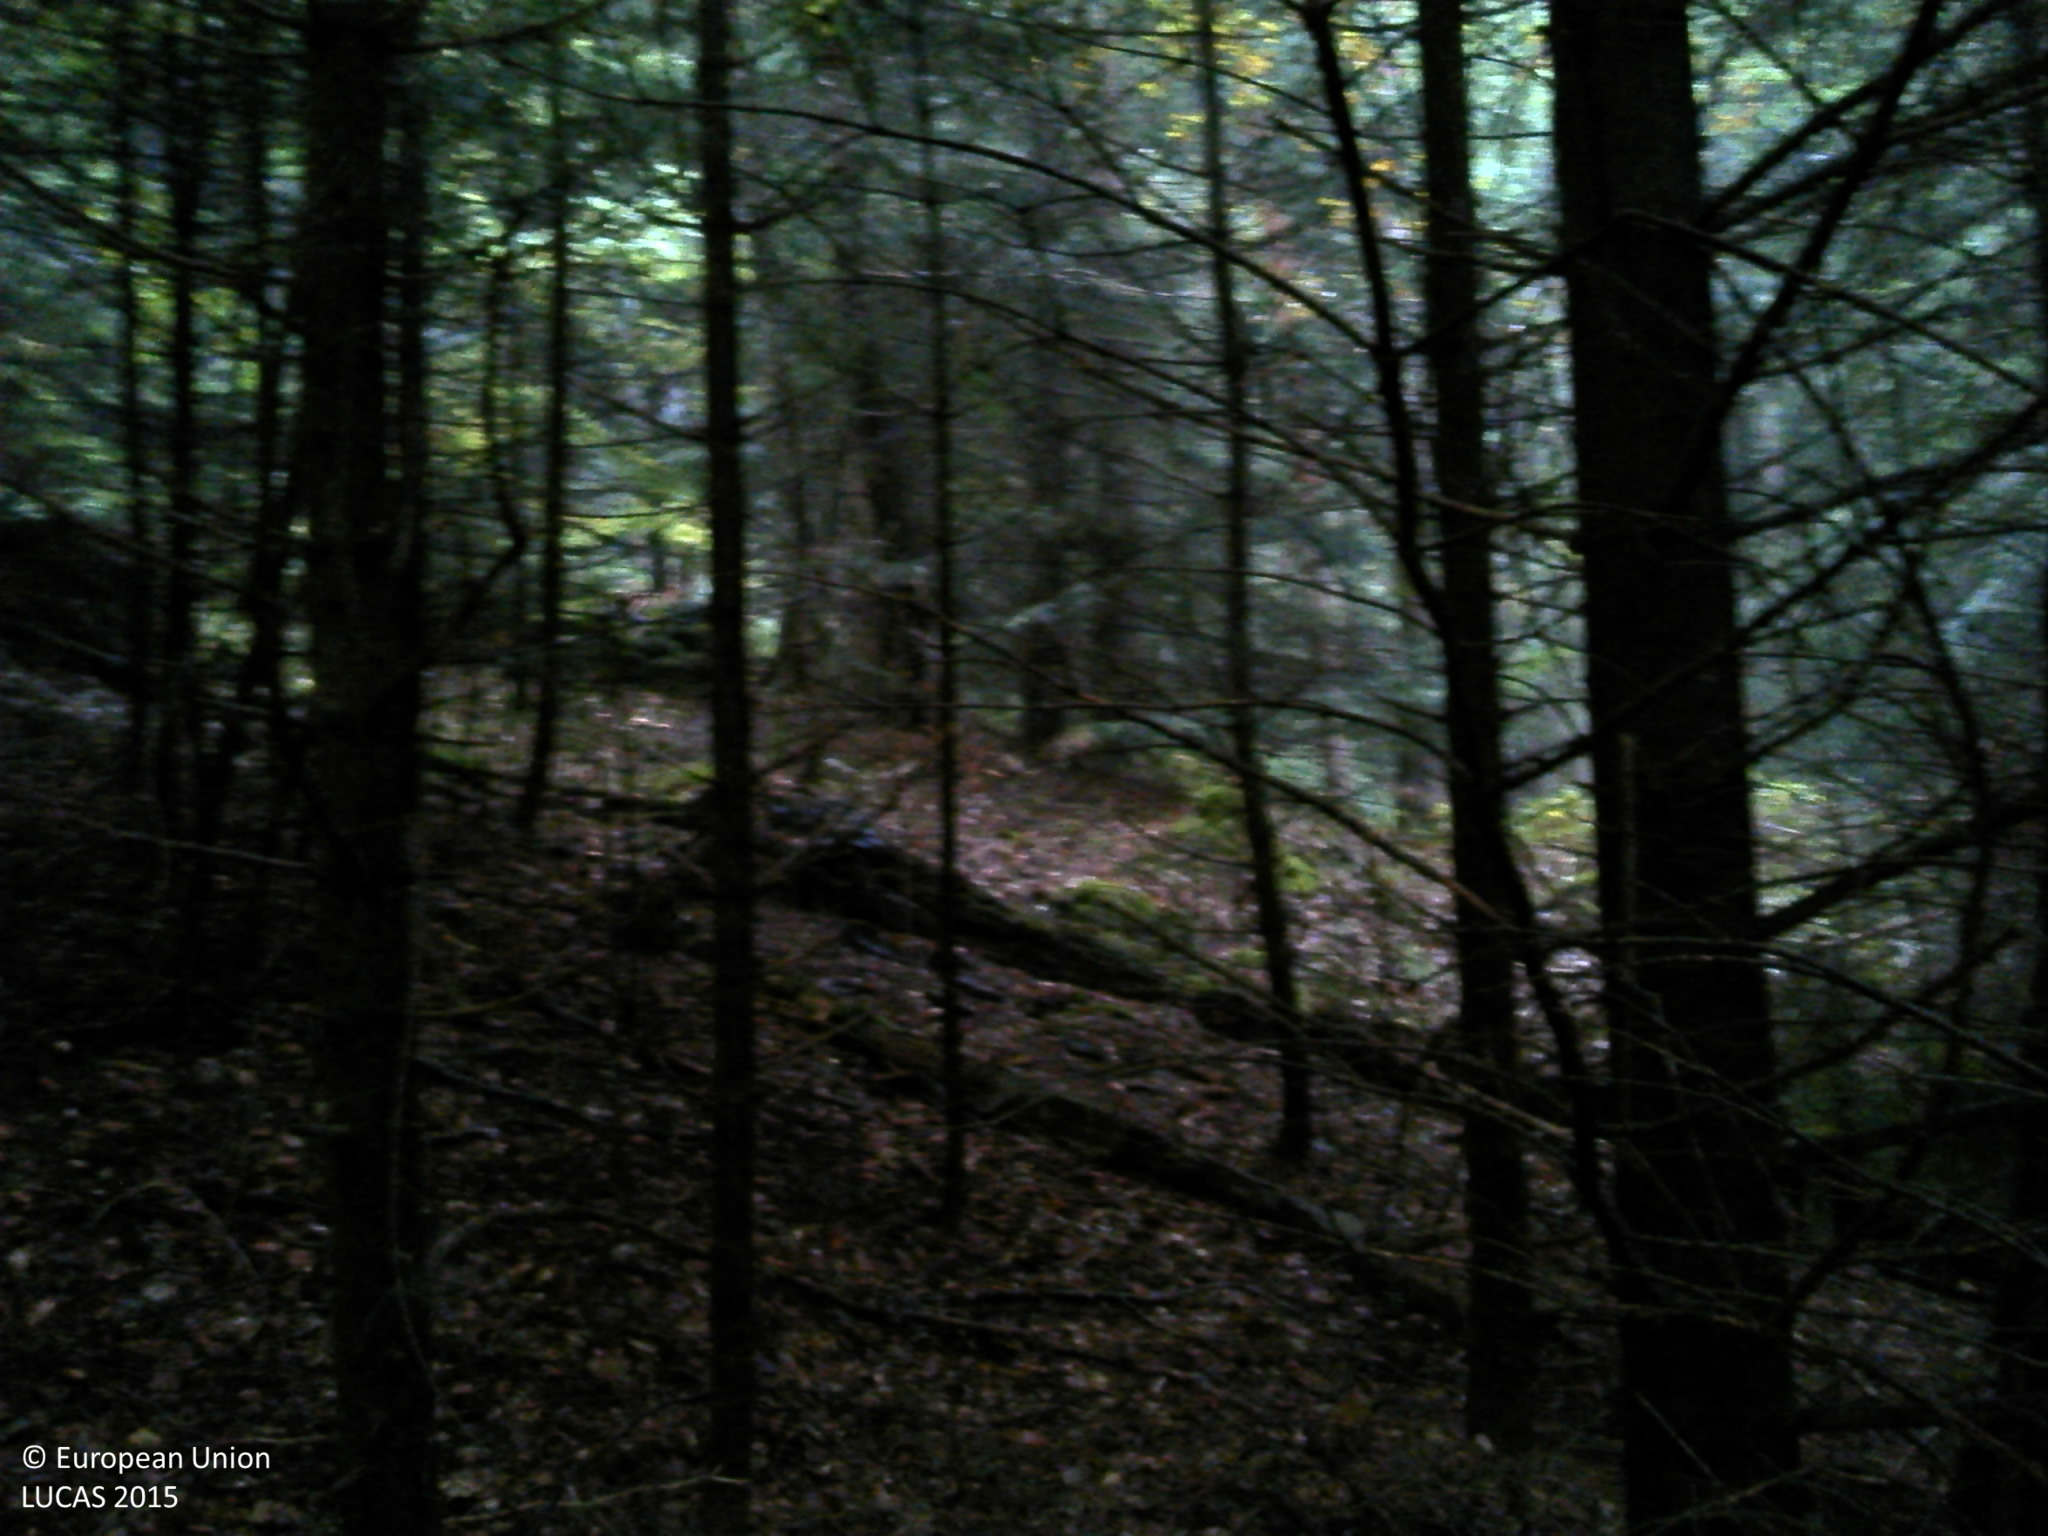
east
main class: Woodland
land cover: Pine dominated mixed woodland
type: mountainous beech forest
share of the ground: > 75 %
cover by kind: coniferous forest trees 50 %, broadleaved forest trees 40 %, unconsolidated bare surface 10 %
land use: Forestry
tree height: > 5 m
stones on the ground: 10 - 25 %
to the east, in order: Pine dominated mixed woodland; Spruce dominated mixed woodland; Shrubland without tree cover; Grass margins; Paved roads, cycling and walking lanes; Grass margins; Ditches and canals; Spruce dominated mixed woodland; Tracks; Spruce dominated mixed woodland
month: October
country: FR
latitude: 45.3754
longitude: 3.7841
